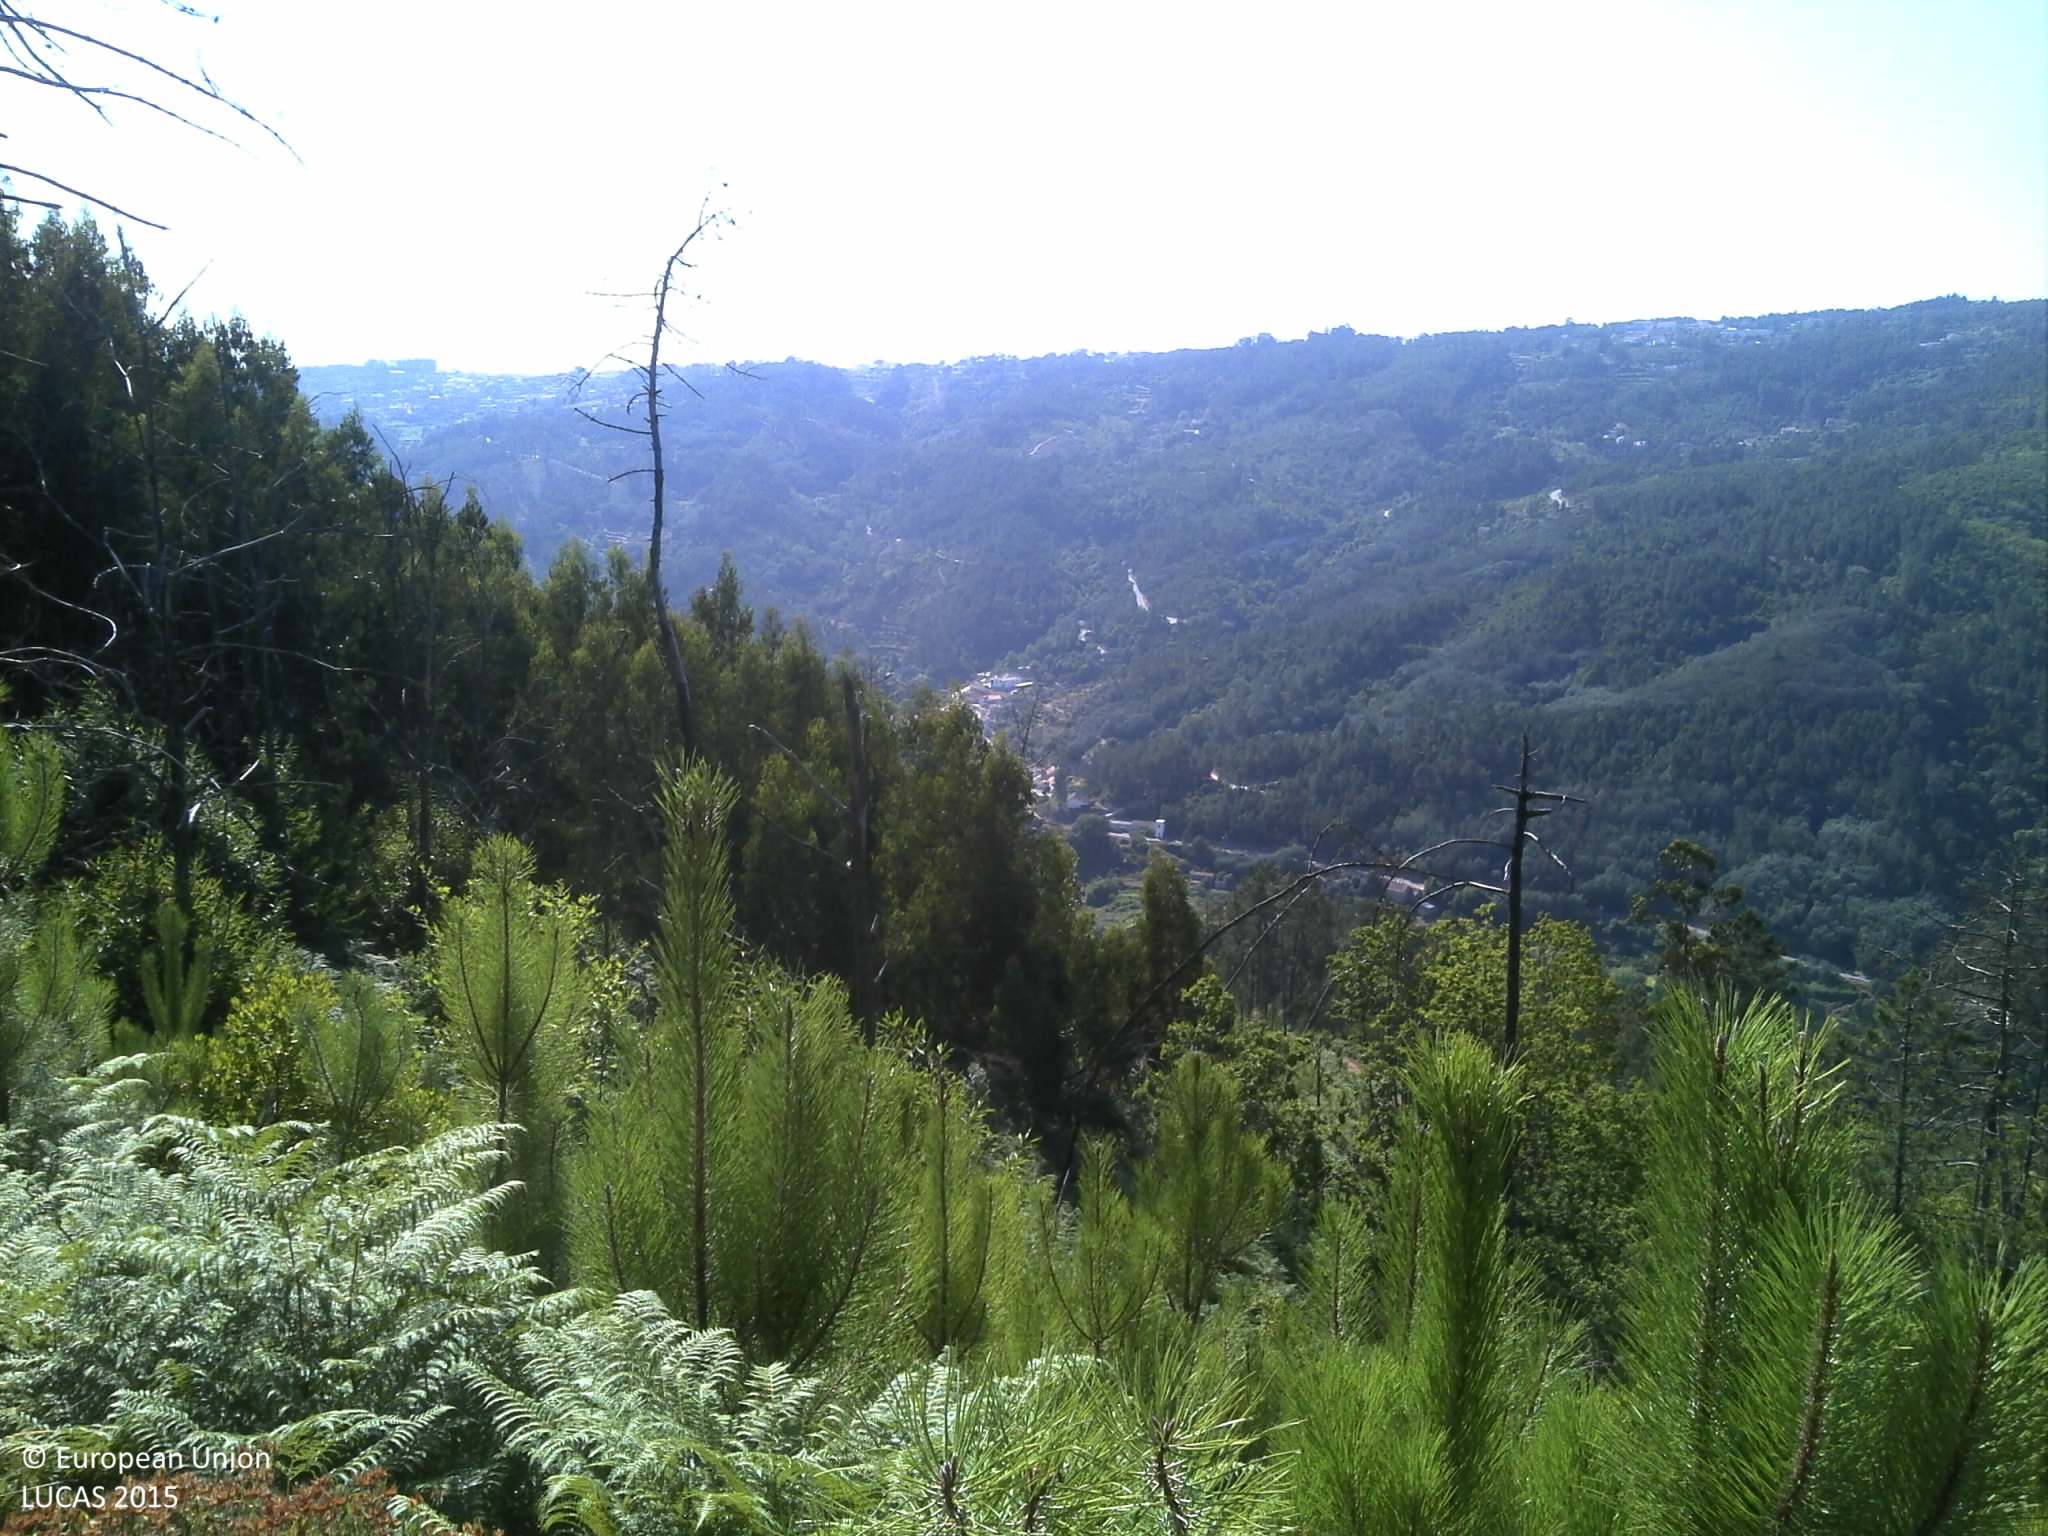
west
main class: Woodland
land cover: Pine dominated coniferous woodland
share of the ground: 50 - 75 %
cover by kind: coniferous forest trees 70 %, shrubs 30 %
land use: Forestry
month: July
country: PT
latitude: 40.3147
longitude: -7.8503
